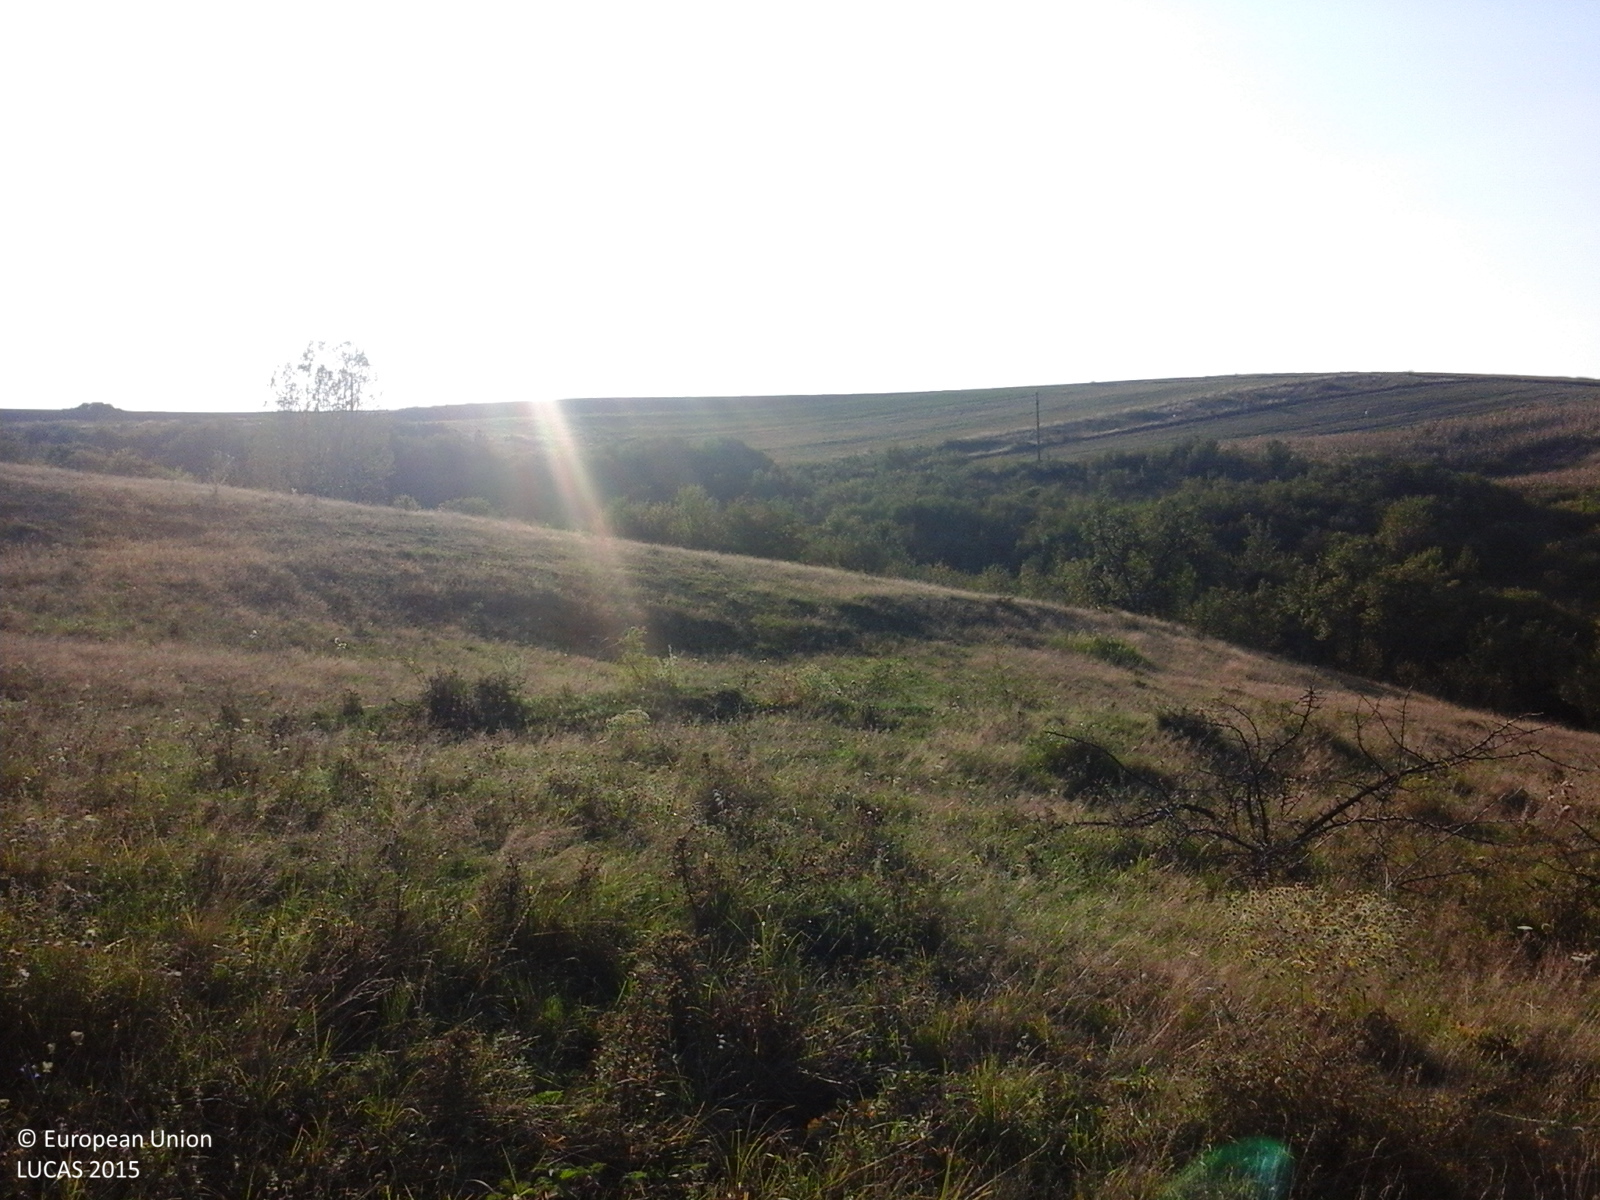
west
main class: Grassland
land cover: Grassland with sparse tree/shrub cover
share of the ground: > 75 %
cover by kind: herbaceous plants 90 %, broadleaved forest trees 5 %, shrubs 5 %
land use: Agriculture (excluding fallow land and kitchen gardens)
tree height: < 5 m
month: September
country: RO
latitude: 47.2422
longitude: 22.7552
